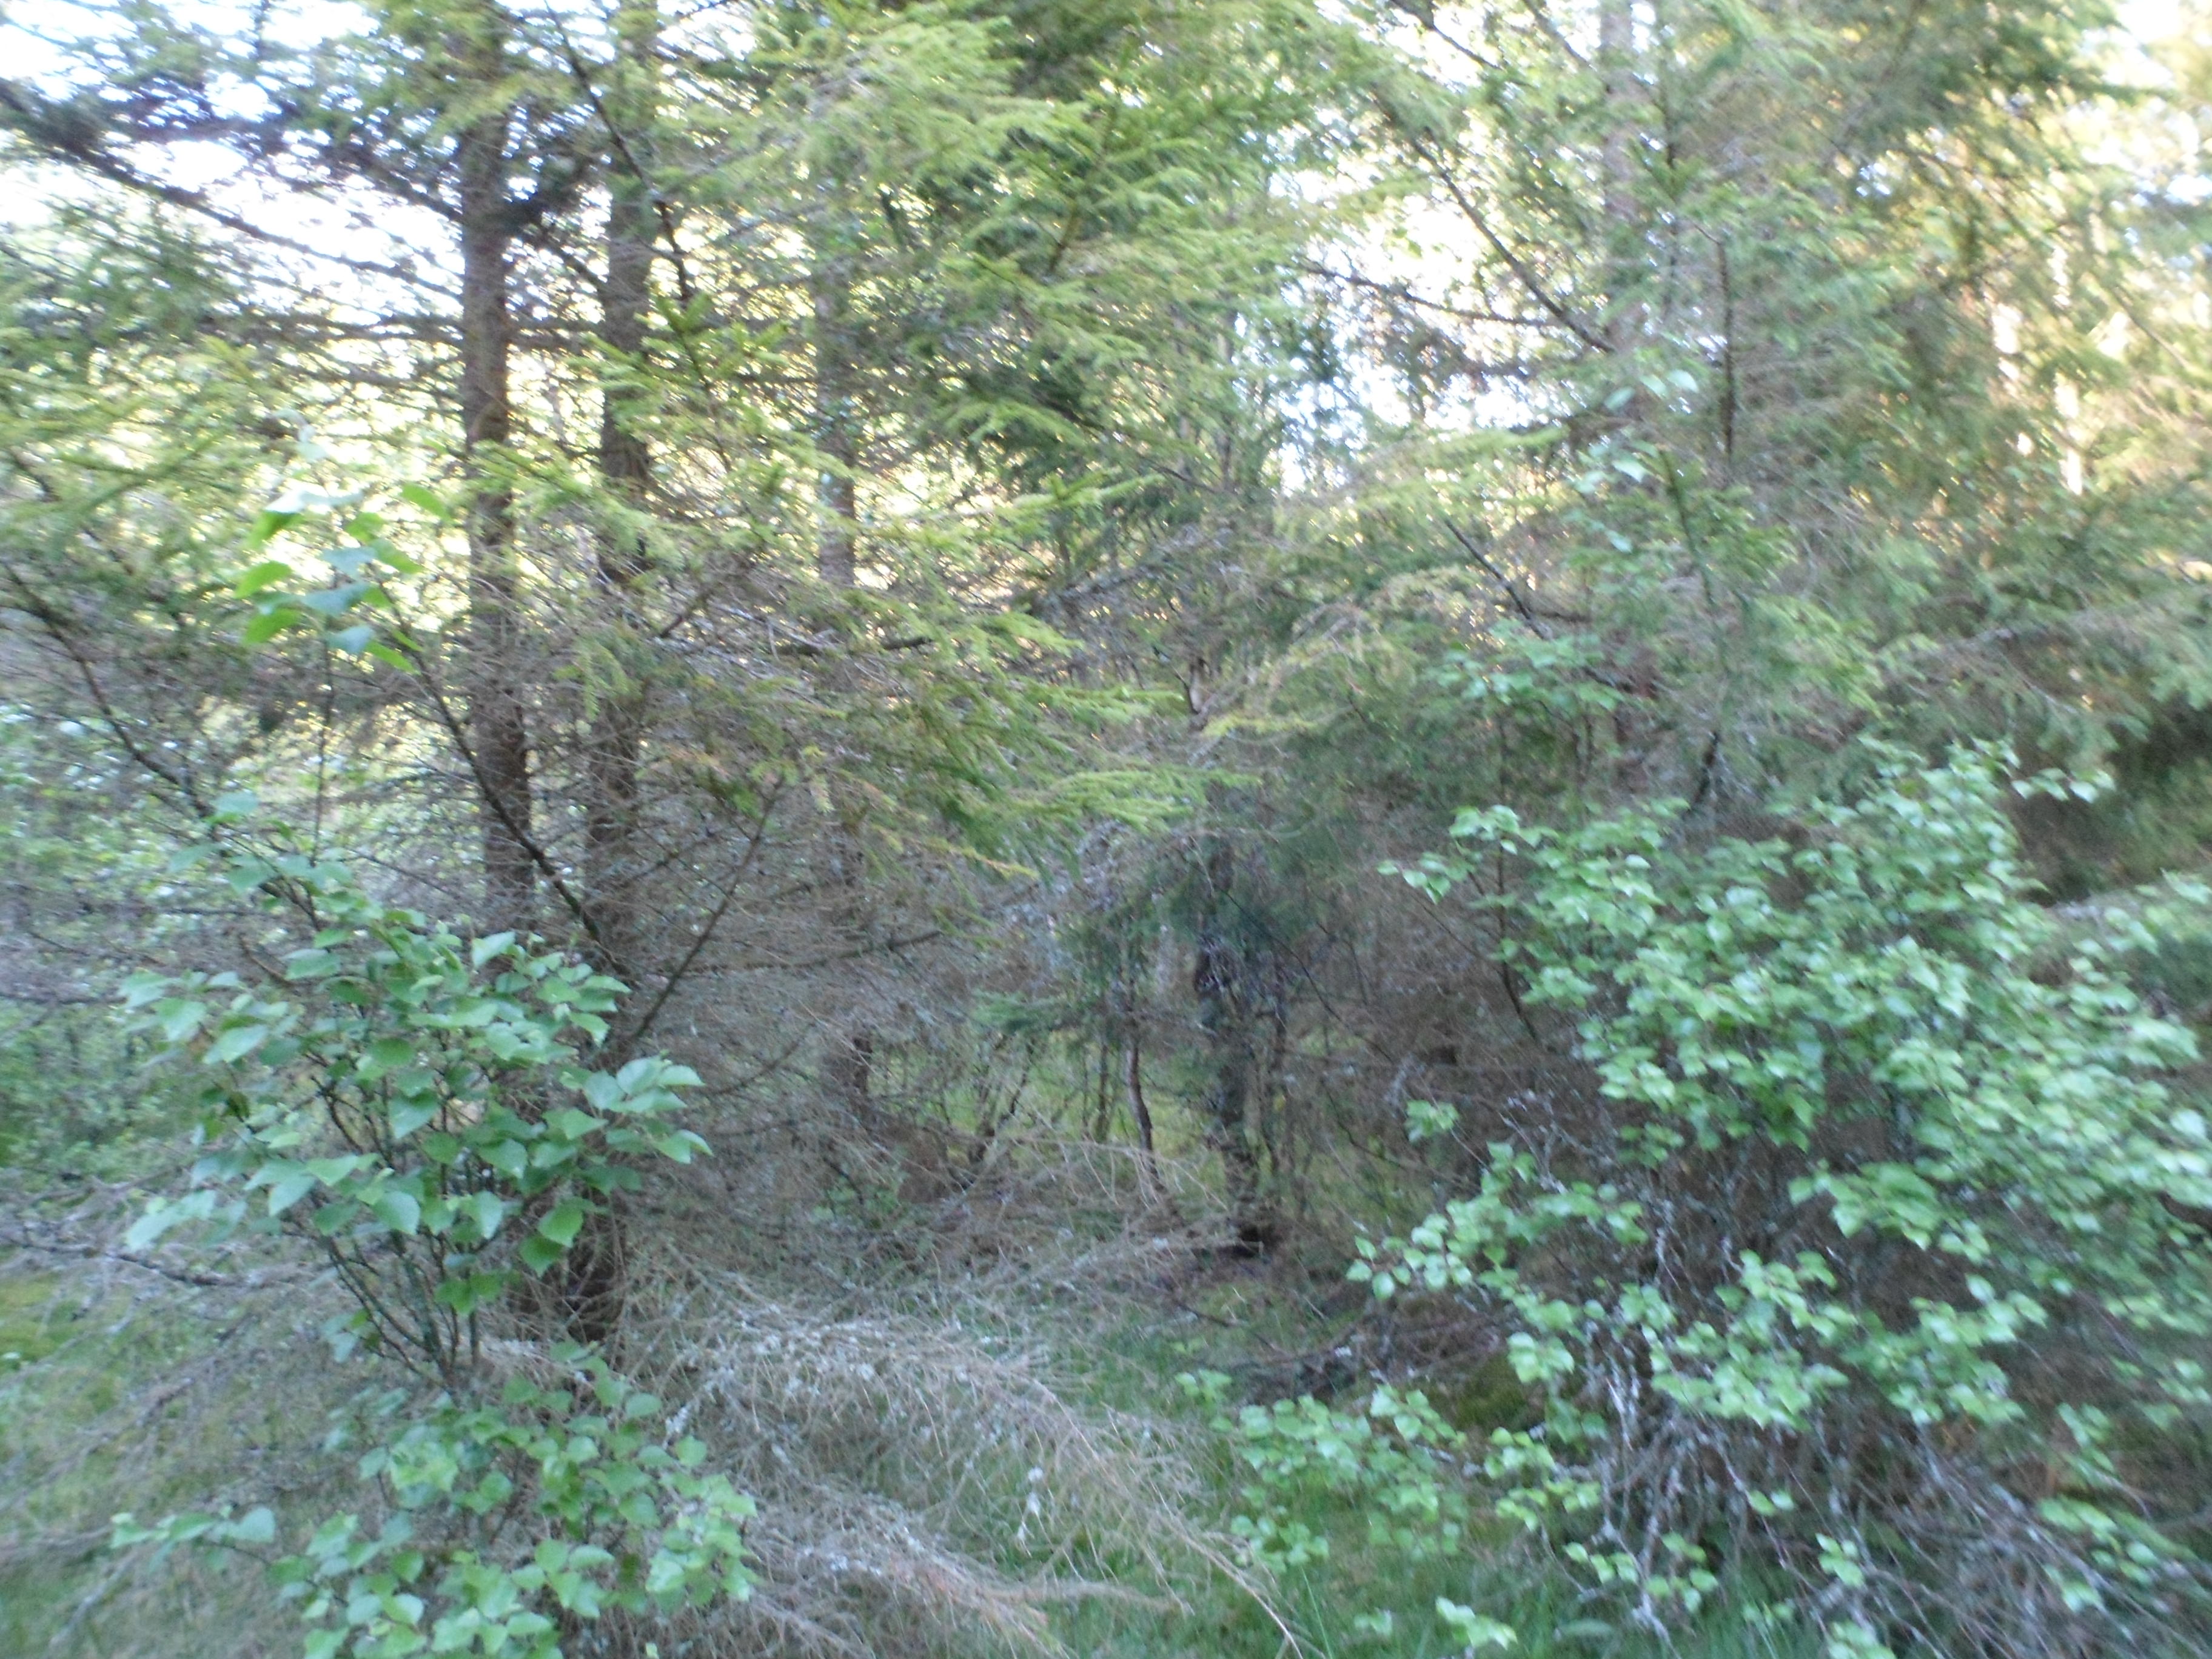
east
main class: Woodland
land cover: Spruce dominated coniferous woodland
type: boreal forest
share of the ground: > 75 %
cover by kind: coniferous forest trees 75 %, broadleaved forest trees 10 %, herbaceous plants 10 %, lichens and mosses 5 %
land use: Forestry
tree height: > 5 m
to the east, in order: Spruce dominated coniferous woodland; Spruce dominated mixed woodland; Ditches and canals; Spruce dominated mixed woodland; Spruce dominated coniferous woodland; Ditches and canals; Pine dominated coniferous woodland; Tracks; Pine dominated coniferous woodland
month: June
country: SE
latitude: 57.3445
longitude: 14.1666
